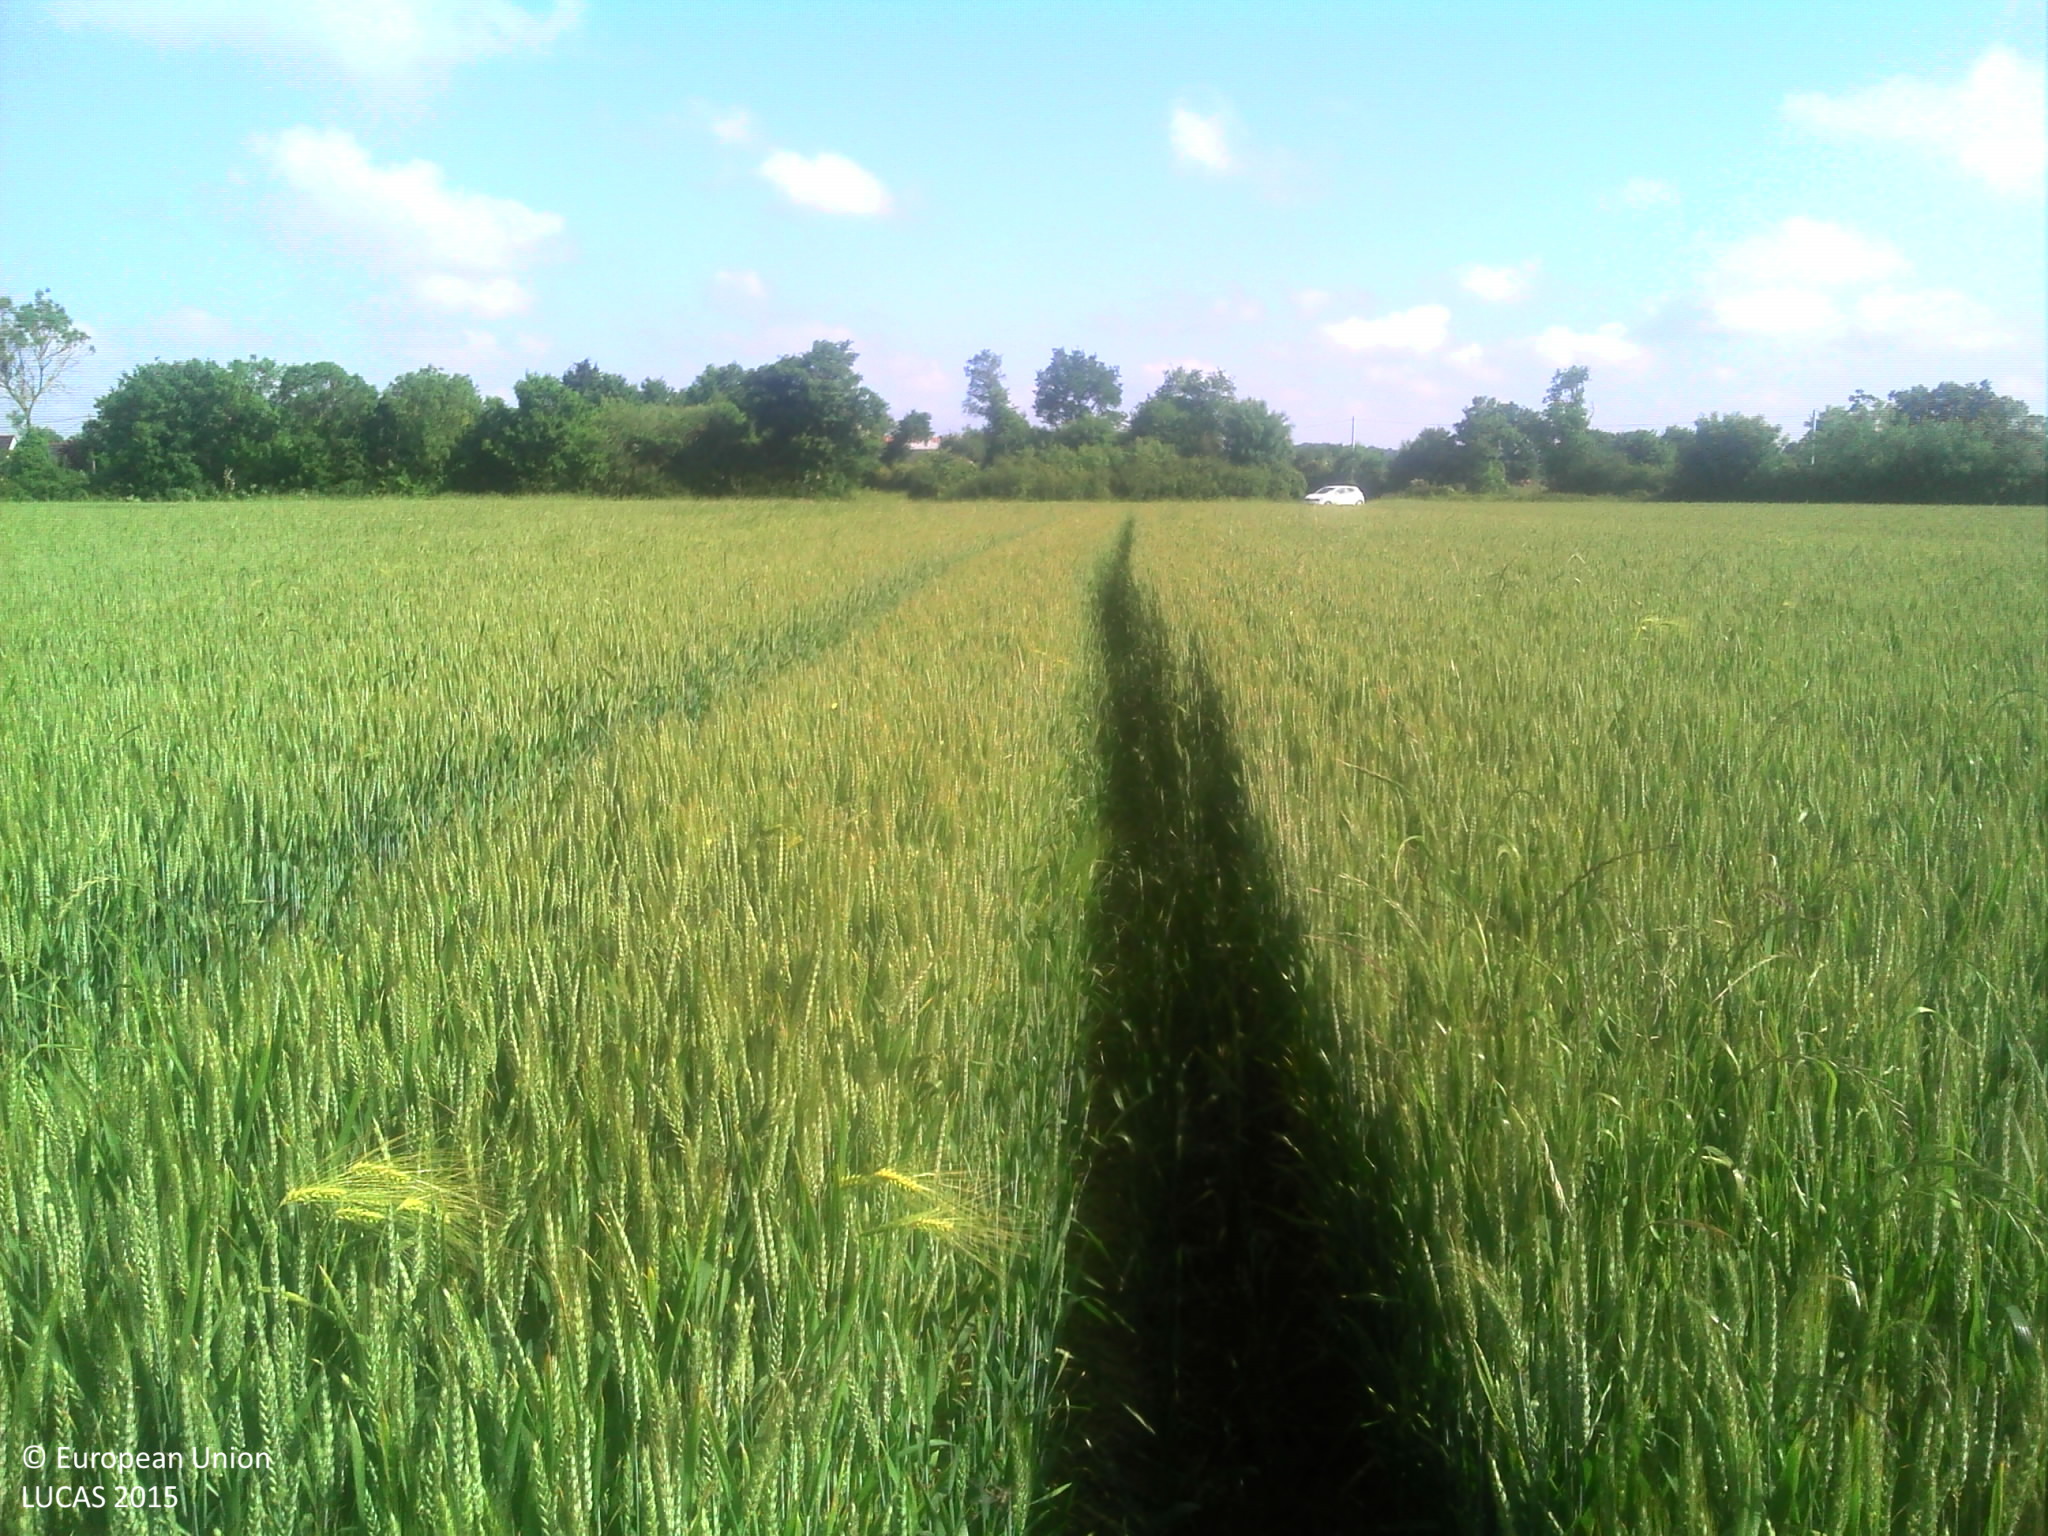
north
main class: Cropland
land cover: Common wheat
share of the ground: > 75 %
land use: Agriculture (excluding fallow land and kitchen gardens)
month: May
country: FR
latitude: 47.4528
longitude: -1.0053
